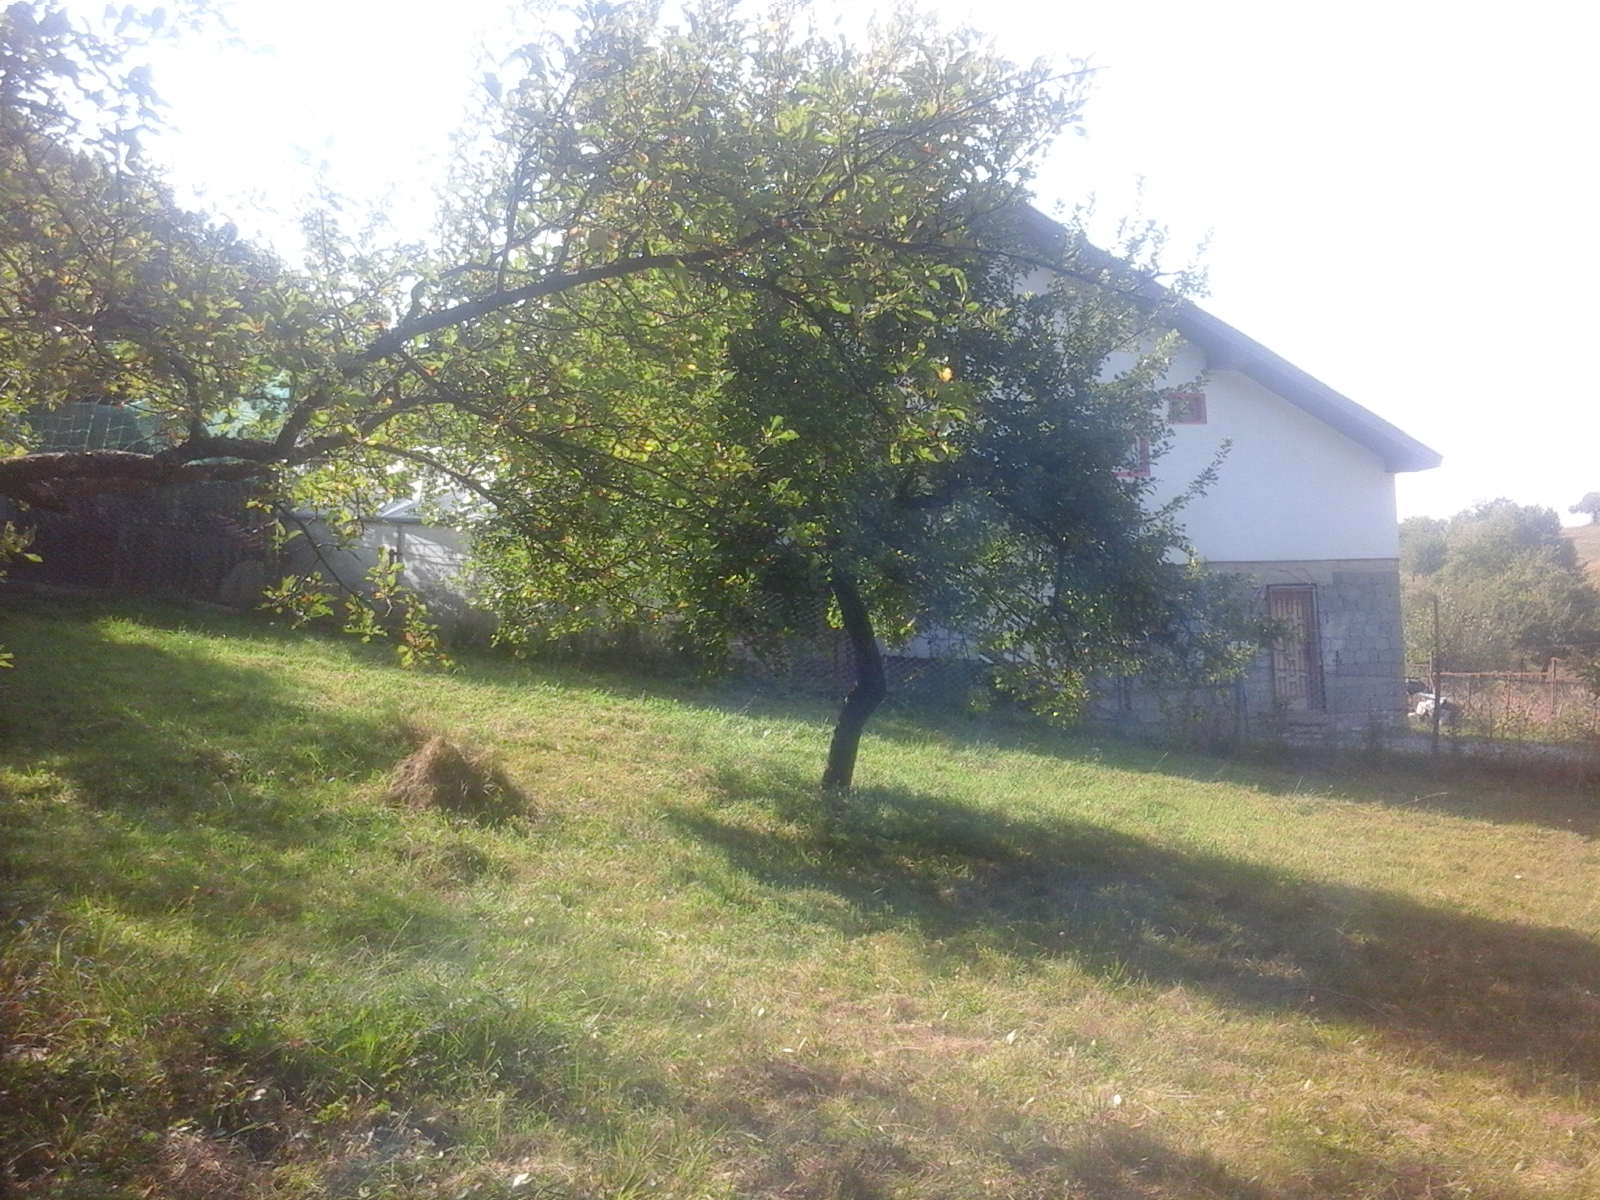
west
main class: Woodland
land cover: Broadleaved woodland
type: beech forest
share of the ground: > 75 %
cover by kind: broadleaved forest trees 100 %
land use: Forestry
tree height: > 5 m
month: September
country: RO
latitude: 47.1128
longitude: 24.4953
